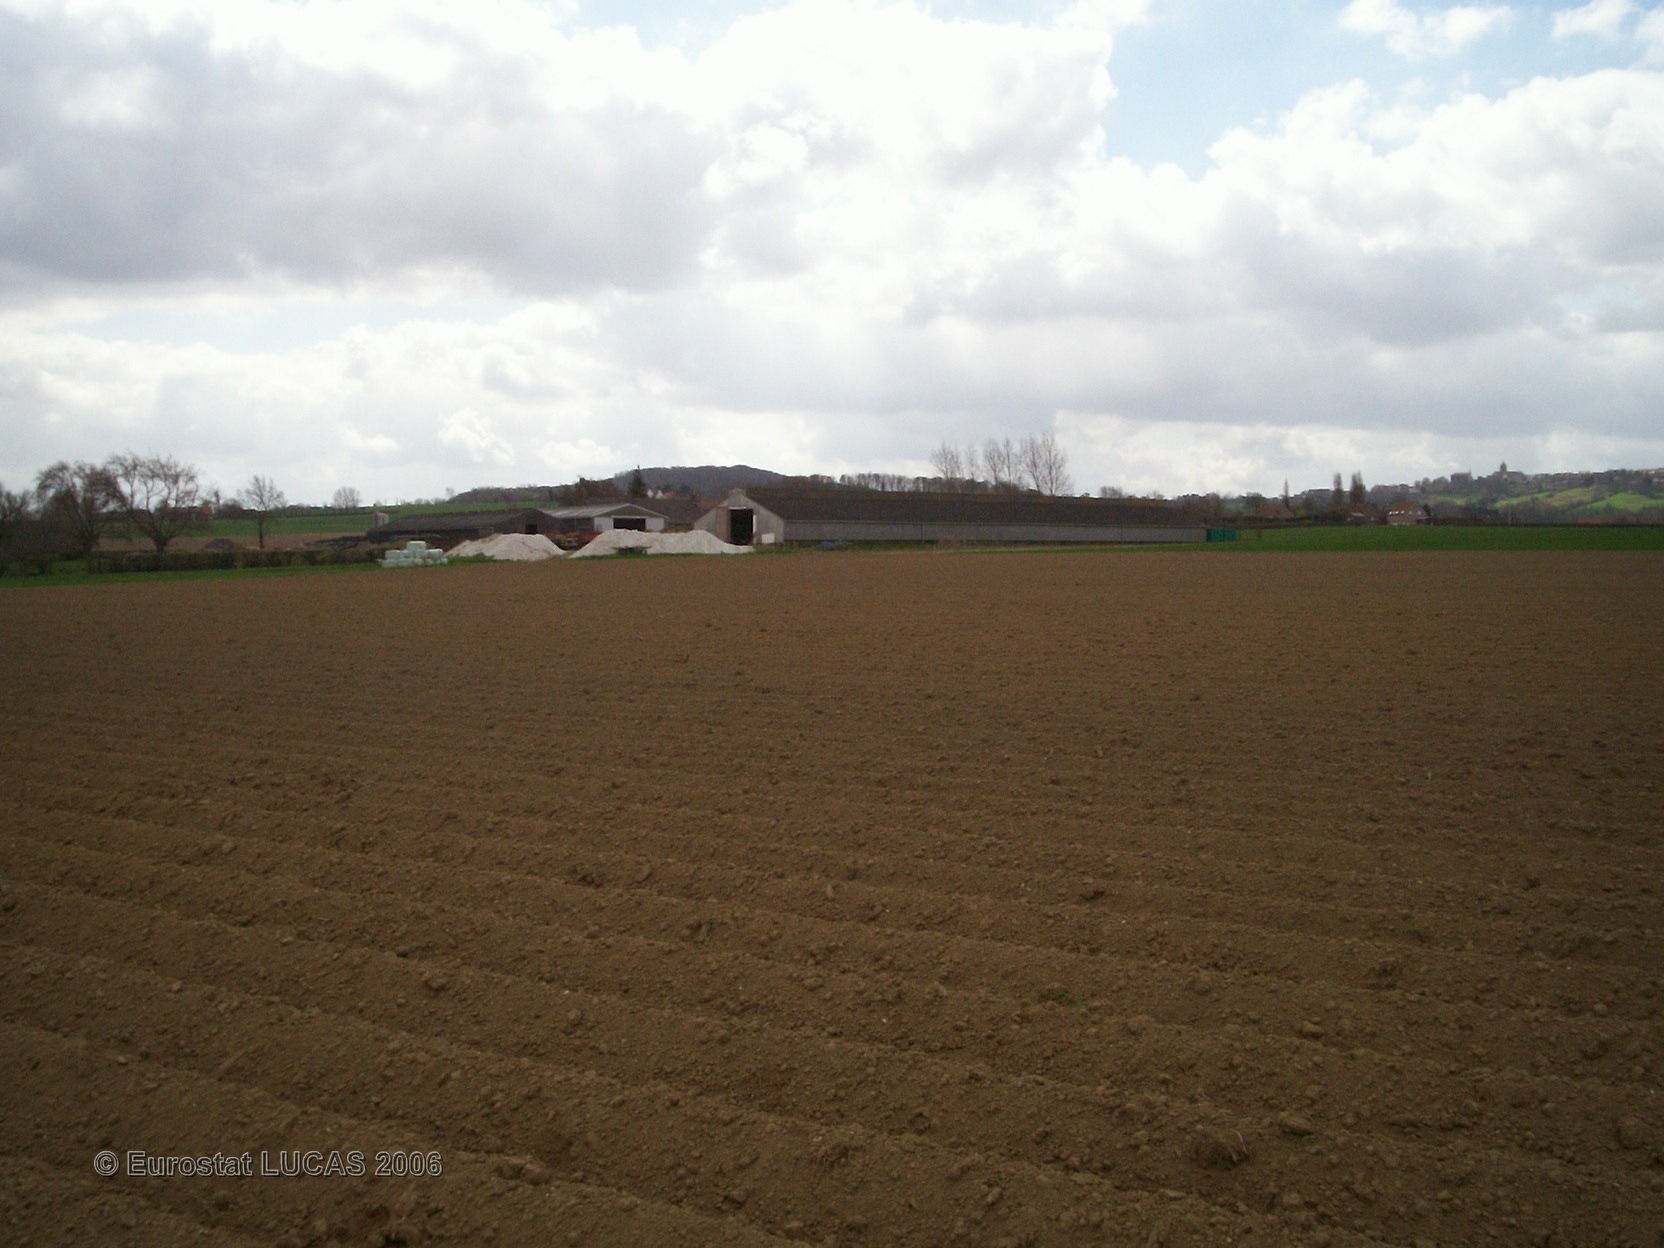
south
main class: Cropland
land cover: Potatoes
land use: Agriculture (excluding fallow land and kitchen gardens)
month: April
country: FR
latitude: 50.8224
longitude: 2.5063
